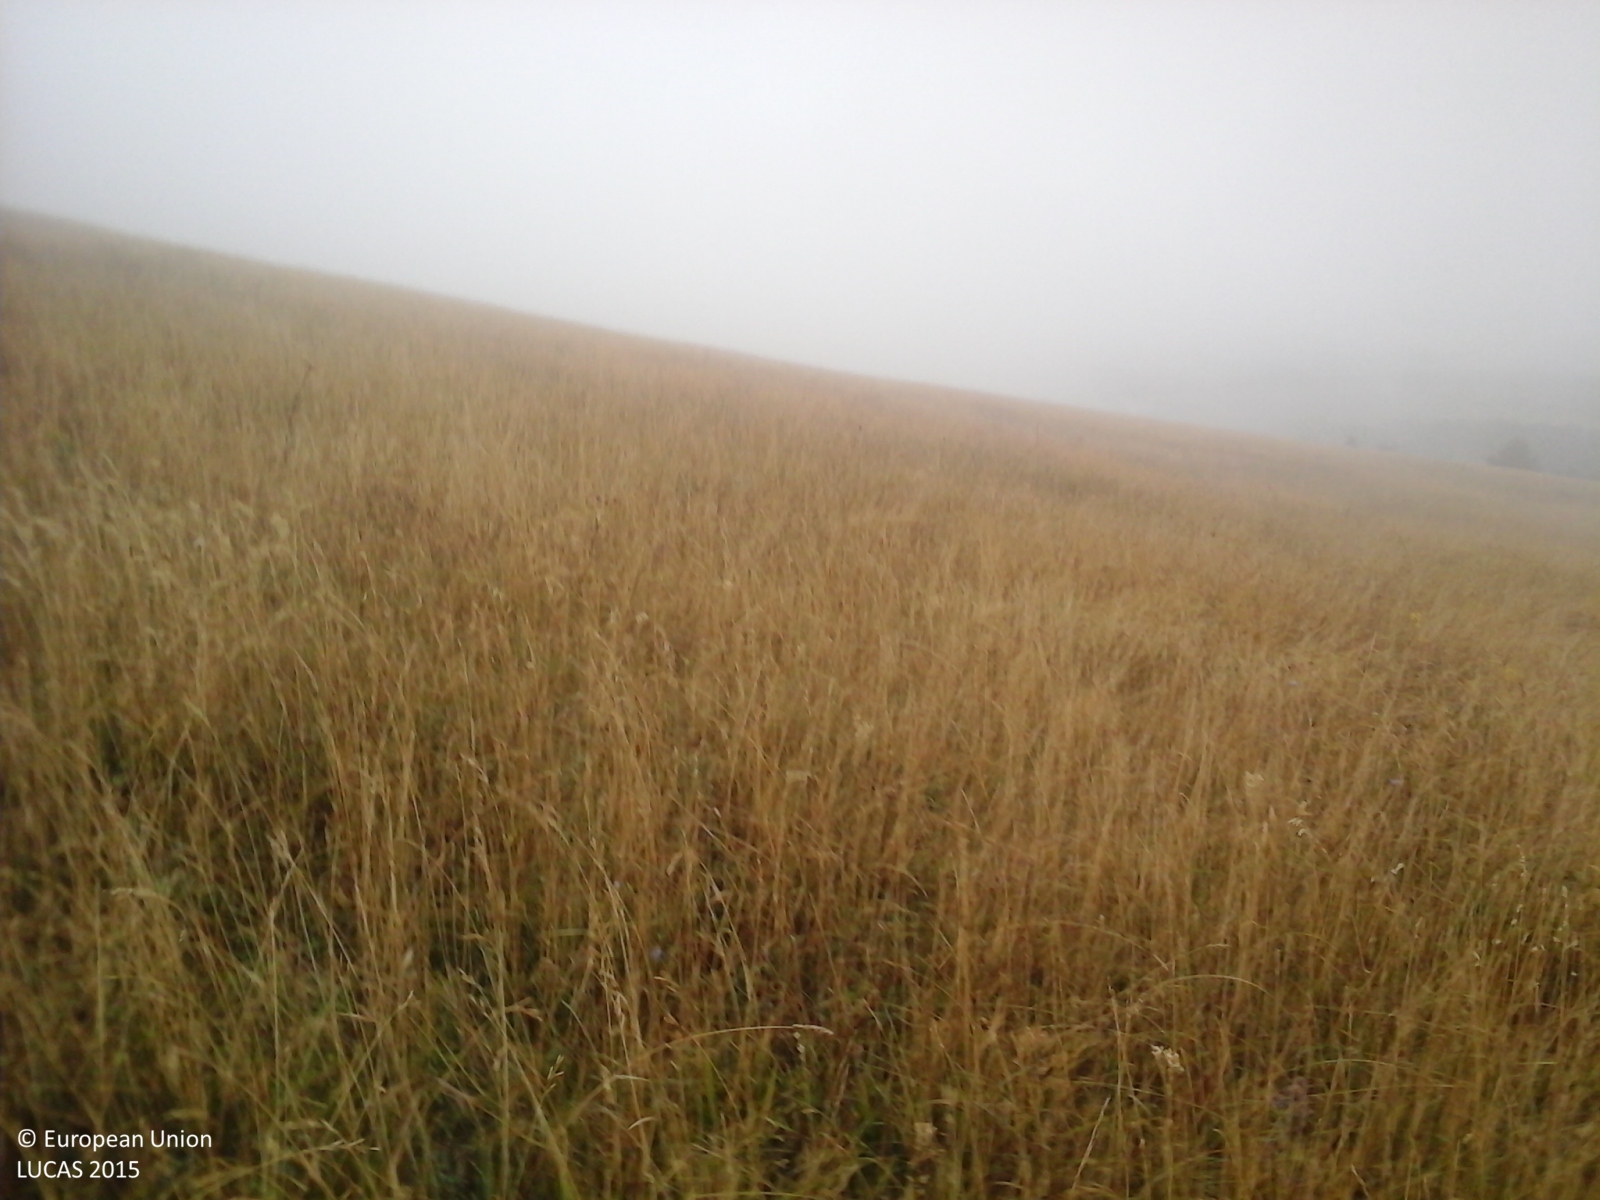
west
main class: Grassland
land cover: Grassland without tree/shrub cover
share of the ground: > 75 %
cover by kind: herbaceous plants 100 %
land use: Agriculture (excluding fallow land and kitchen gardens)
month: September
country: IT
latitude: 43.4408
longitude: 12.9947
